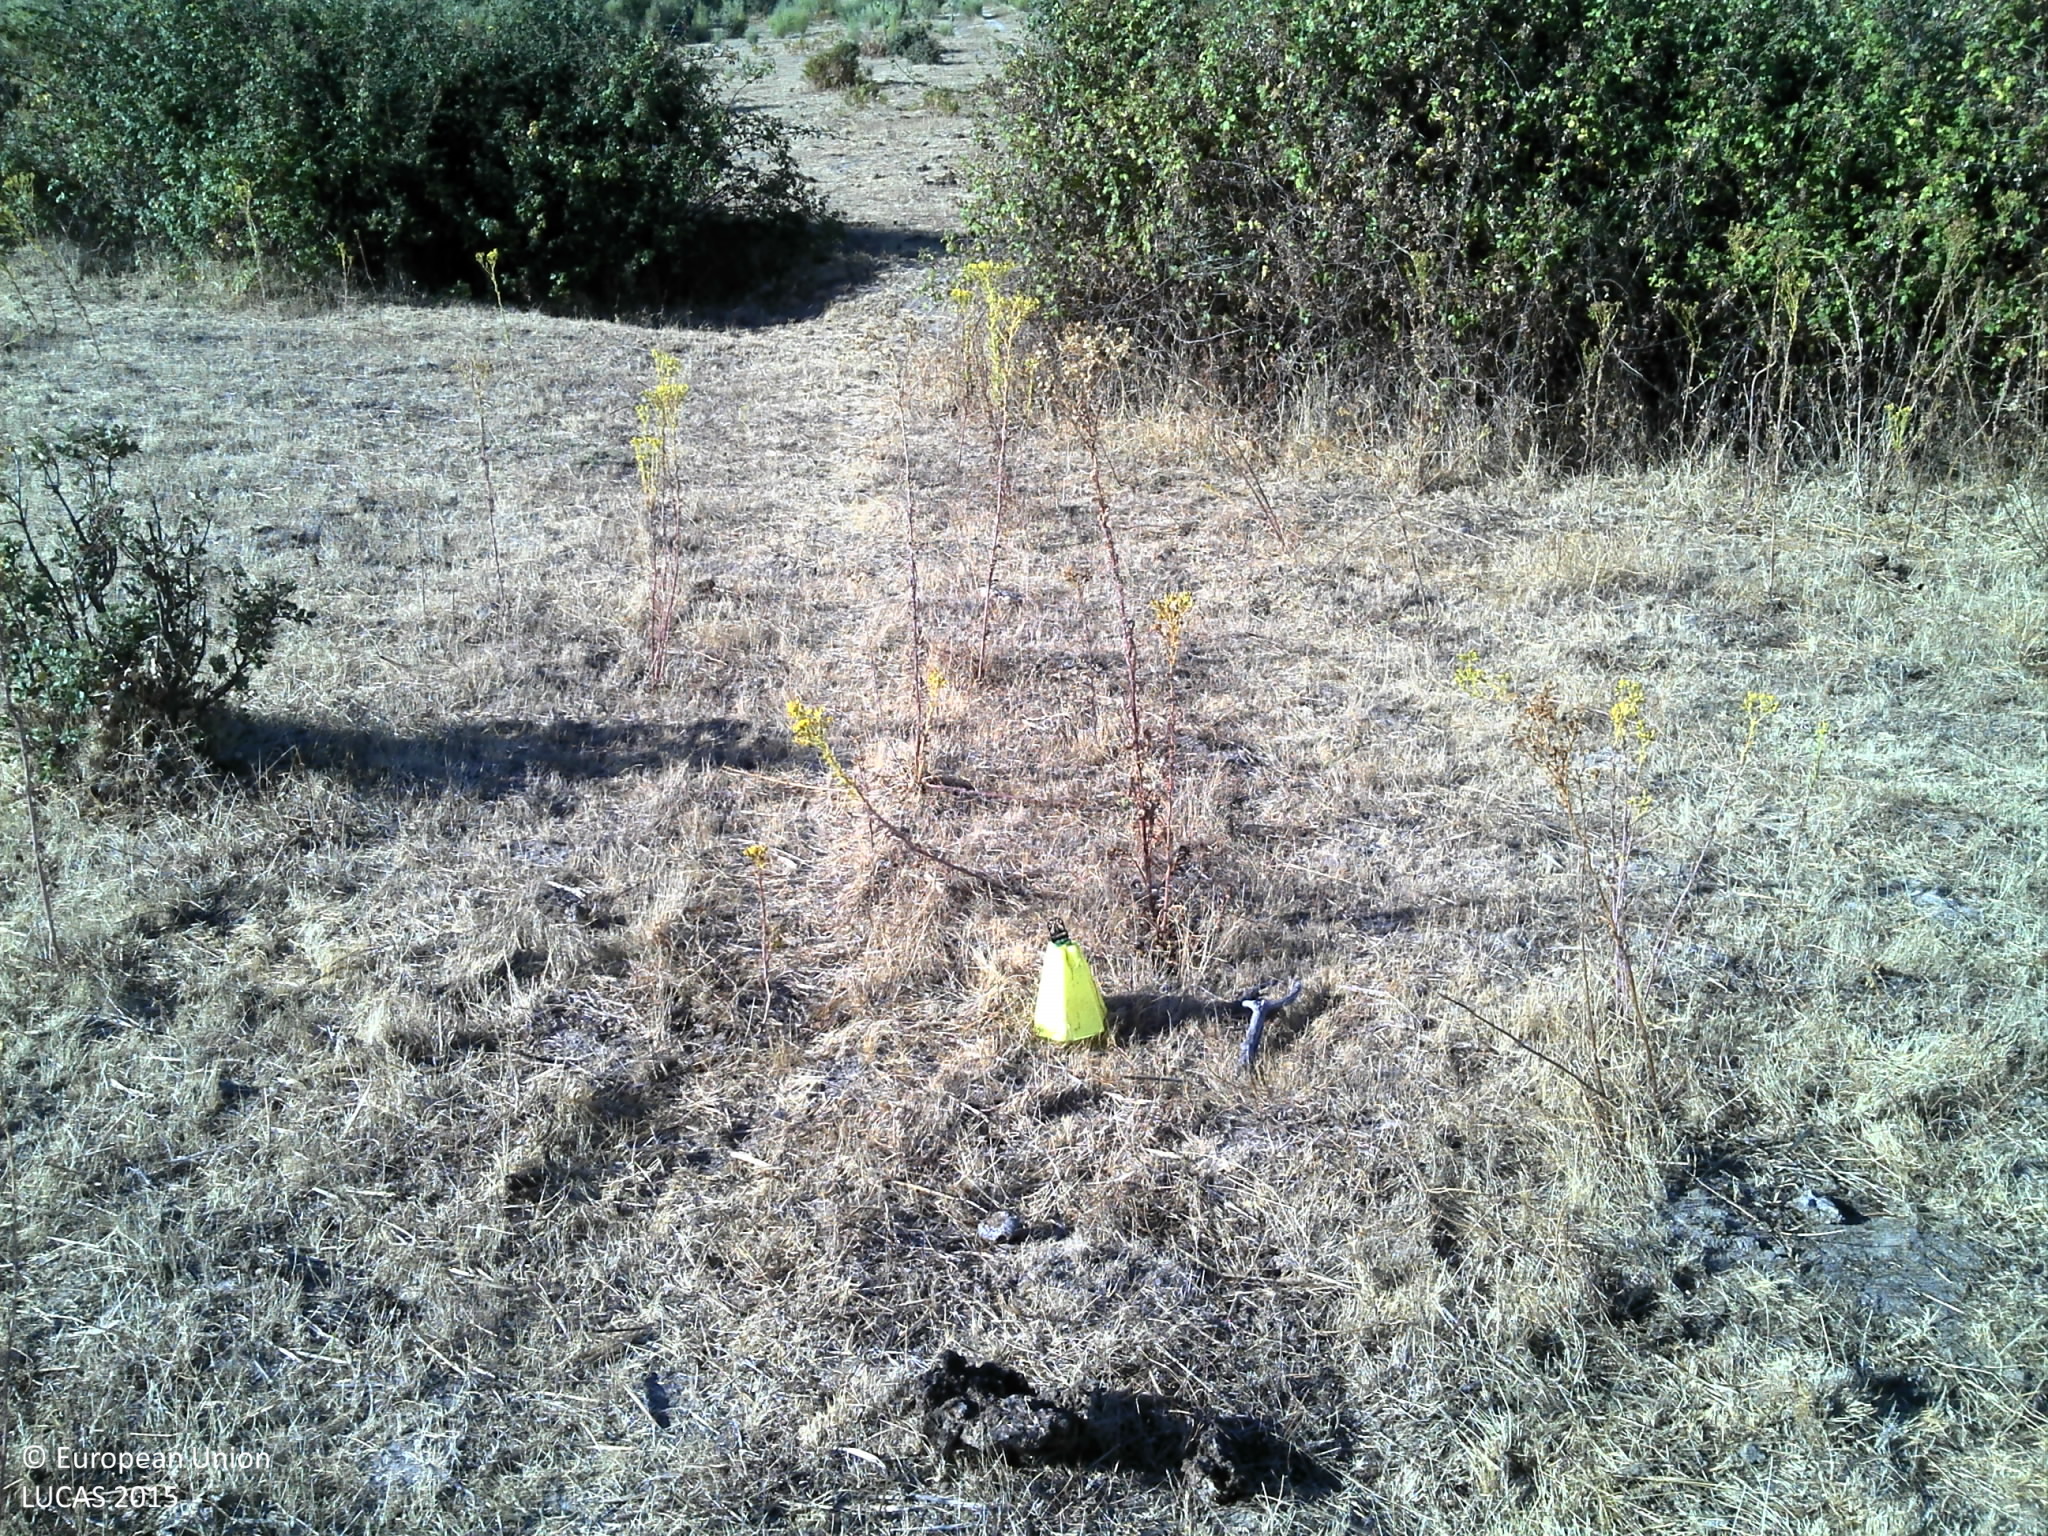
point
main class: Grassland
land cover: Grassland with sparse tree/shrub cover
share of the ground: 50 - 75 %
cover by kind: herbaceous plants 55 %, unconsolidated bare surface 35 %, broadleaved forest trees 5 %, shrubs 5 %
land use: Agriculture (excluding fallow land and kitchen gardens)
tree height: < 5 m
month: August
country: PT
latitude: 39.4702
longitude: -7.4223
